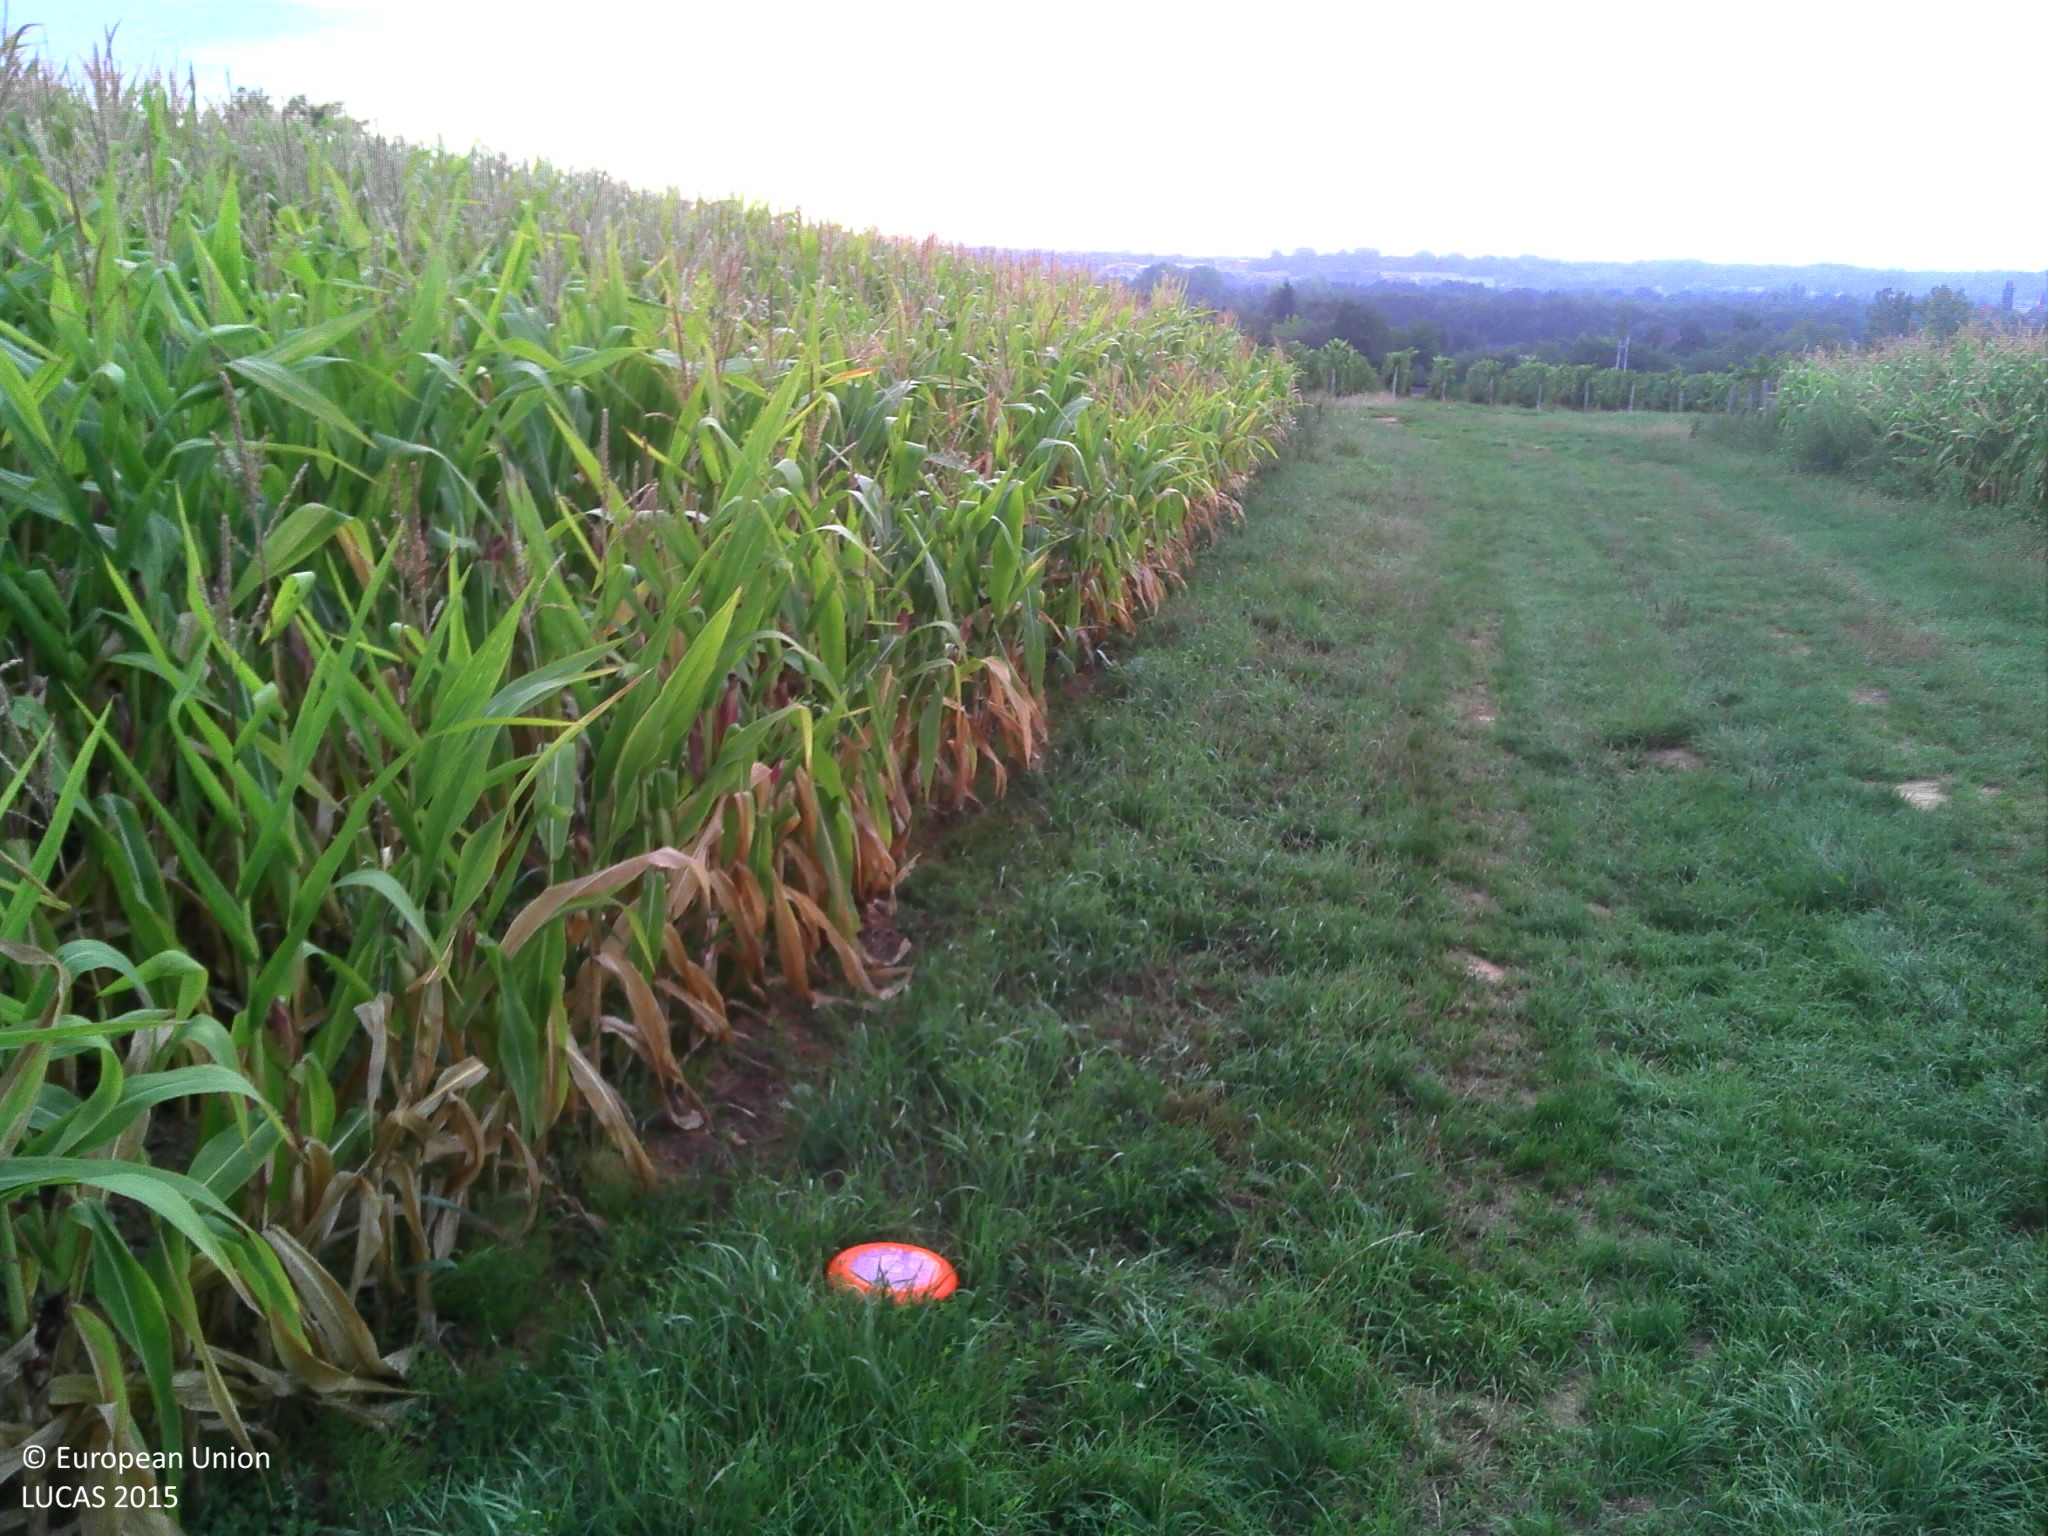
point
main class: Cropland
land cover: Maize
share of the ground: > 75 %
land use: Agriculture (excluding fallow land and kitchen gardens)
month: August
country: FR
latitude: 46.3903
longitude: 4.8655
